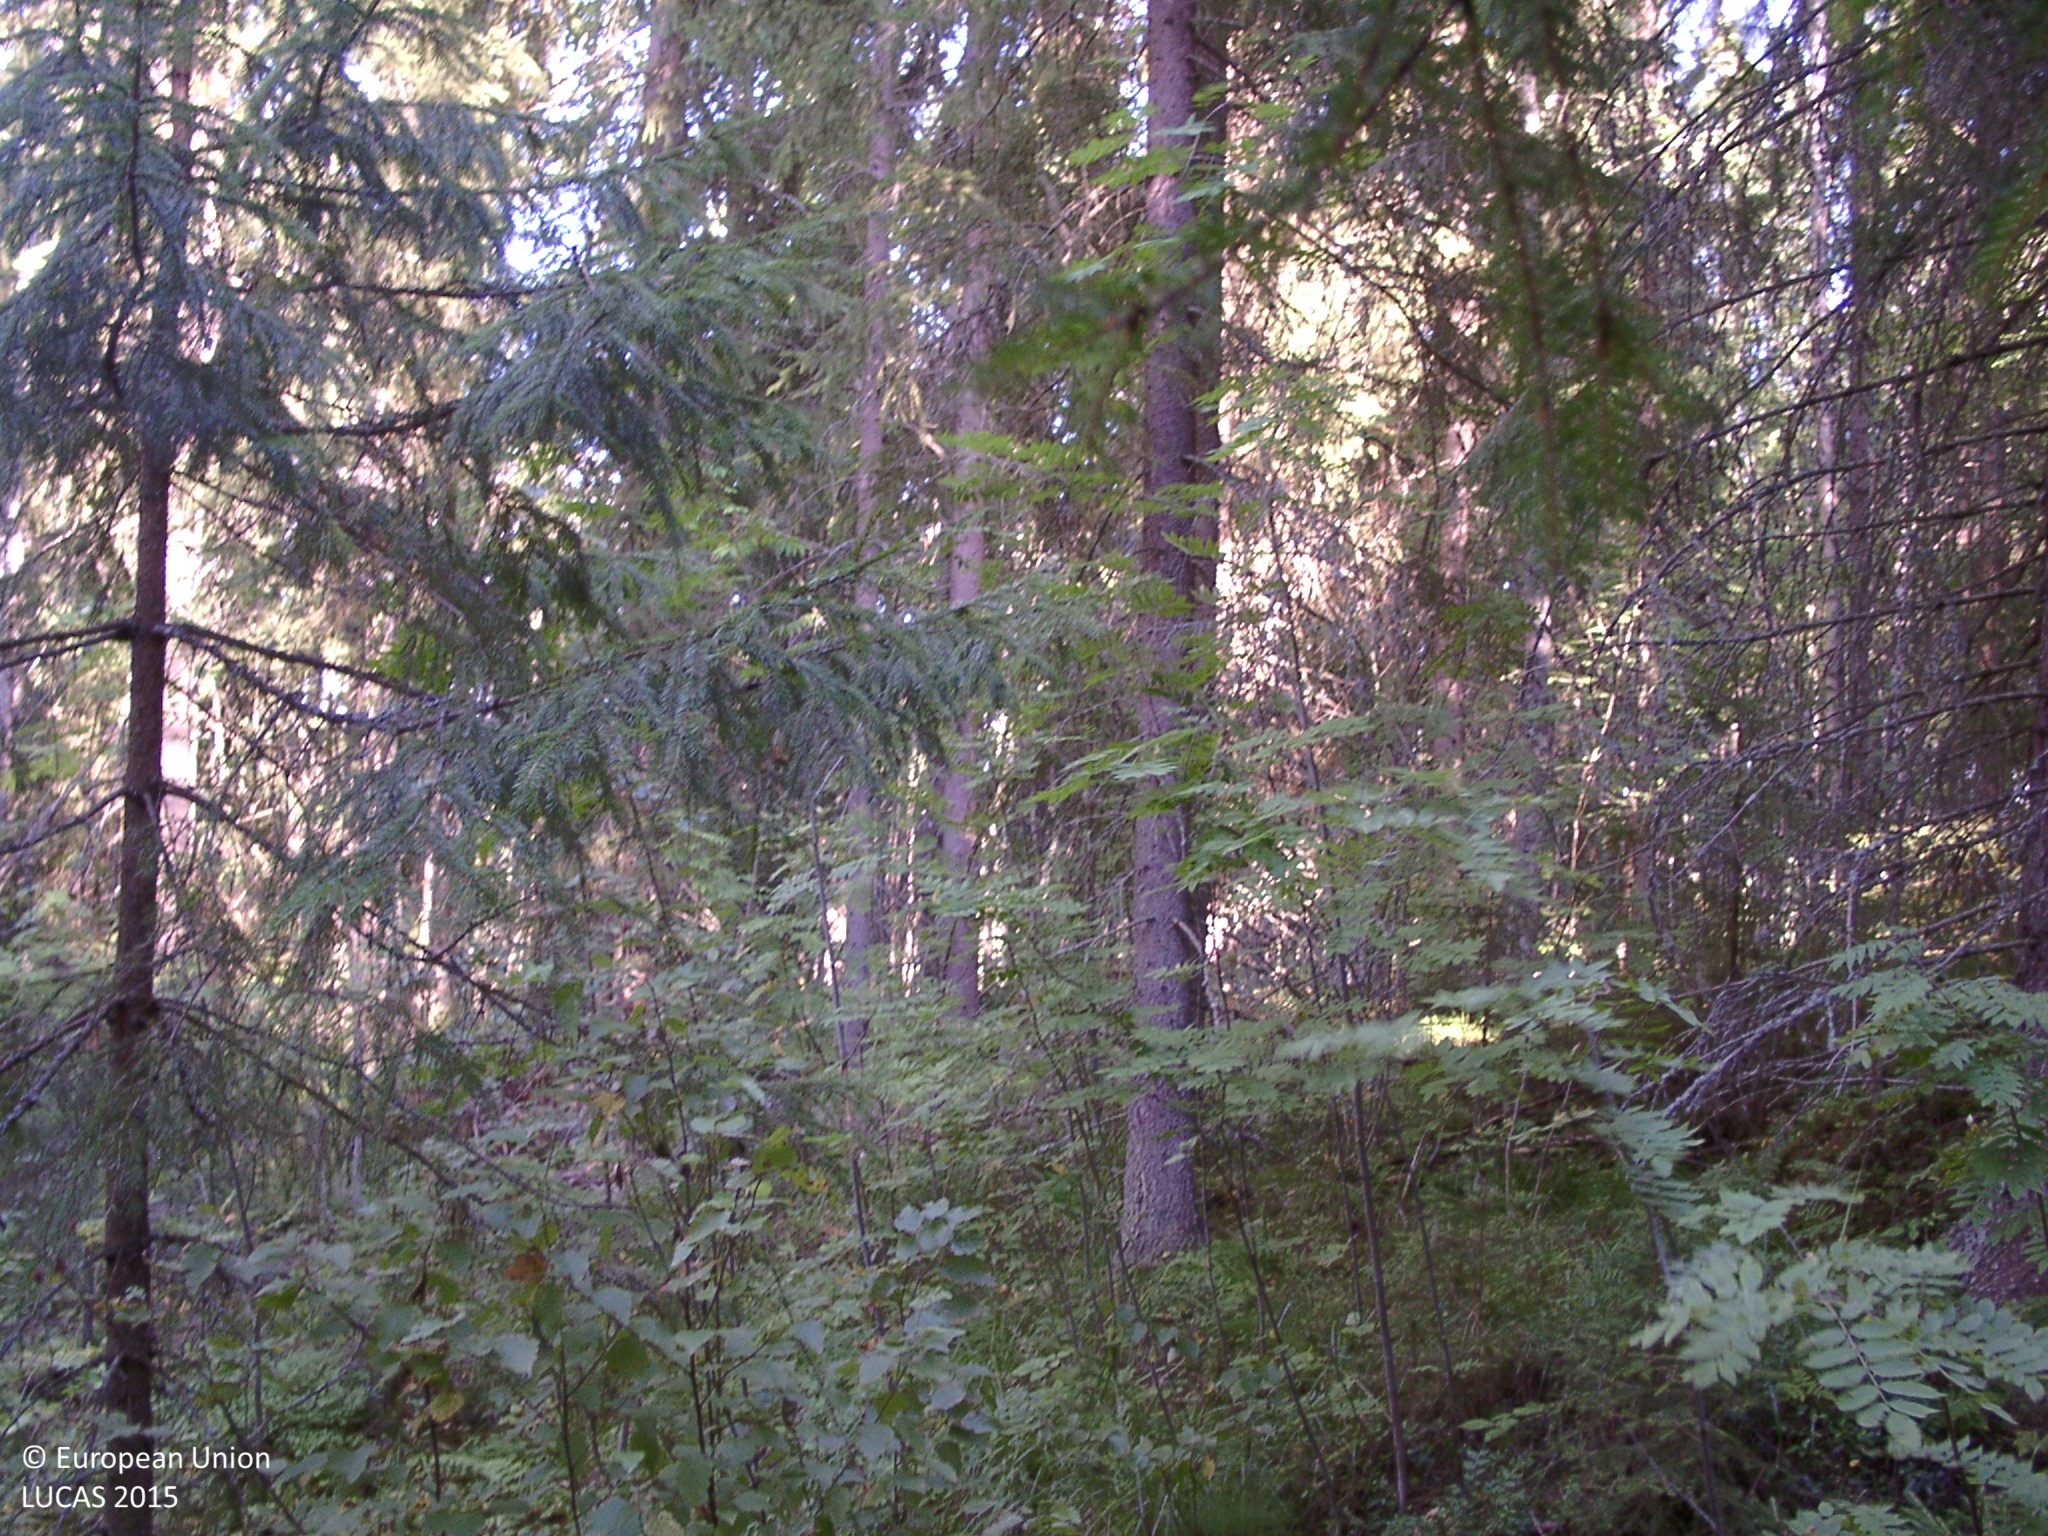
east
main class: Woodland
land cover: Spruce dominated mixed woodland
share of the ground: > 75 %
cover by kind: coniferous forest trees 60 %, broadleaved forest trees 20 %, shrubs 10 %, herbaceous plants 5 %, lichens and mosses 5 %
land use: Forestry
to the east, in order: Spruce dominated mixed woodland; Shrubland with sparse tree cover; Ditches and canals; Tracks; Shruby margins; Spruce dominated mixed woodland; Tracks; Shrubland without tree cover; Ditches and canals; Spruce dominated mixed woodland; Shrubland without tree cover; Groves; Ditches and canals; Broadleaved woodland; Ditches and canals; Shruby margins; Grassland without tree/shrub cover
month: August
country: FI
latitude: 62.3347
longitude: 25.6980
